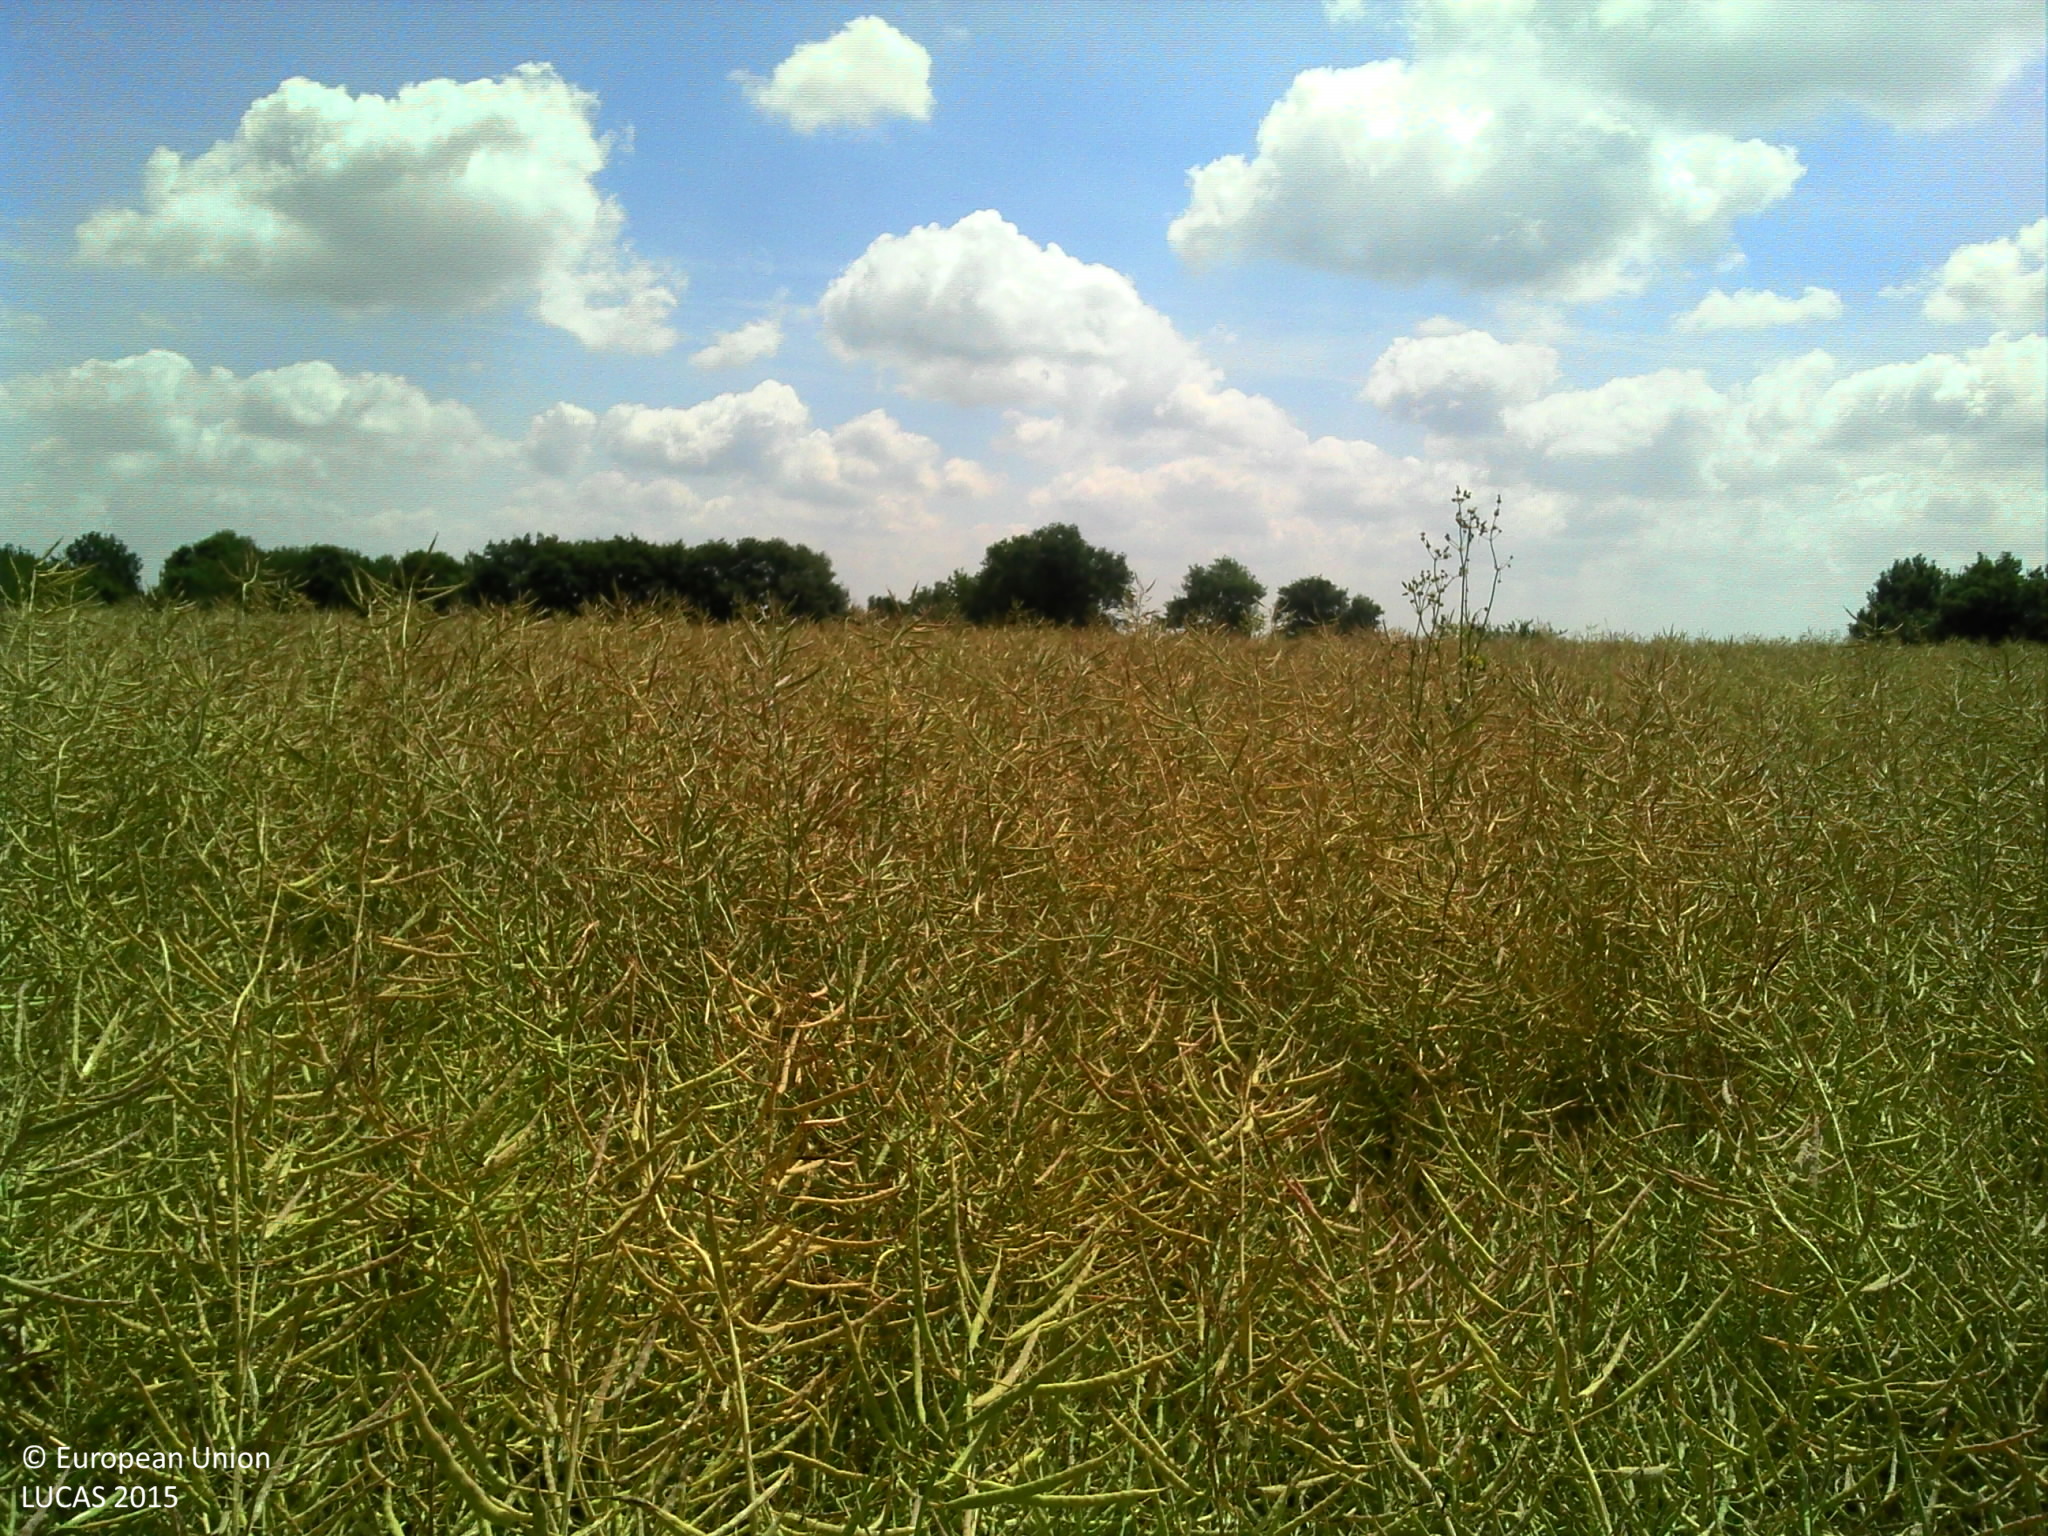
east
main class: Cropland
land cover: Rape and turnip rape
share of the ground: > 75 %
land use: Agriculture (excluding fallow land and kitchen gardens)
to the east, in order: Rape and turnip rape; Tracks; Broadleaved woodland; Common wheat
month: June
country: FR
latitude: 47.4492
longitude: 2.5788
